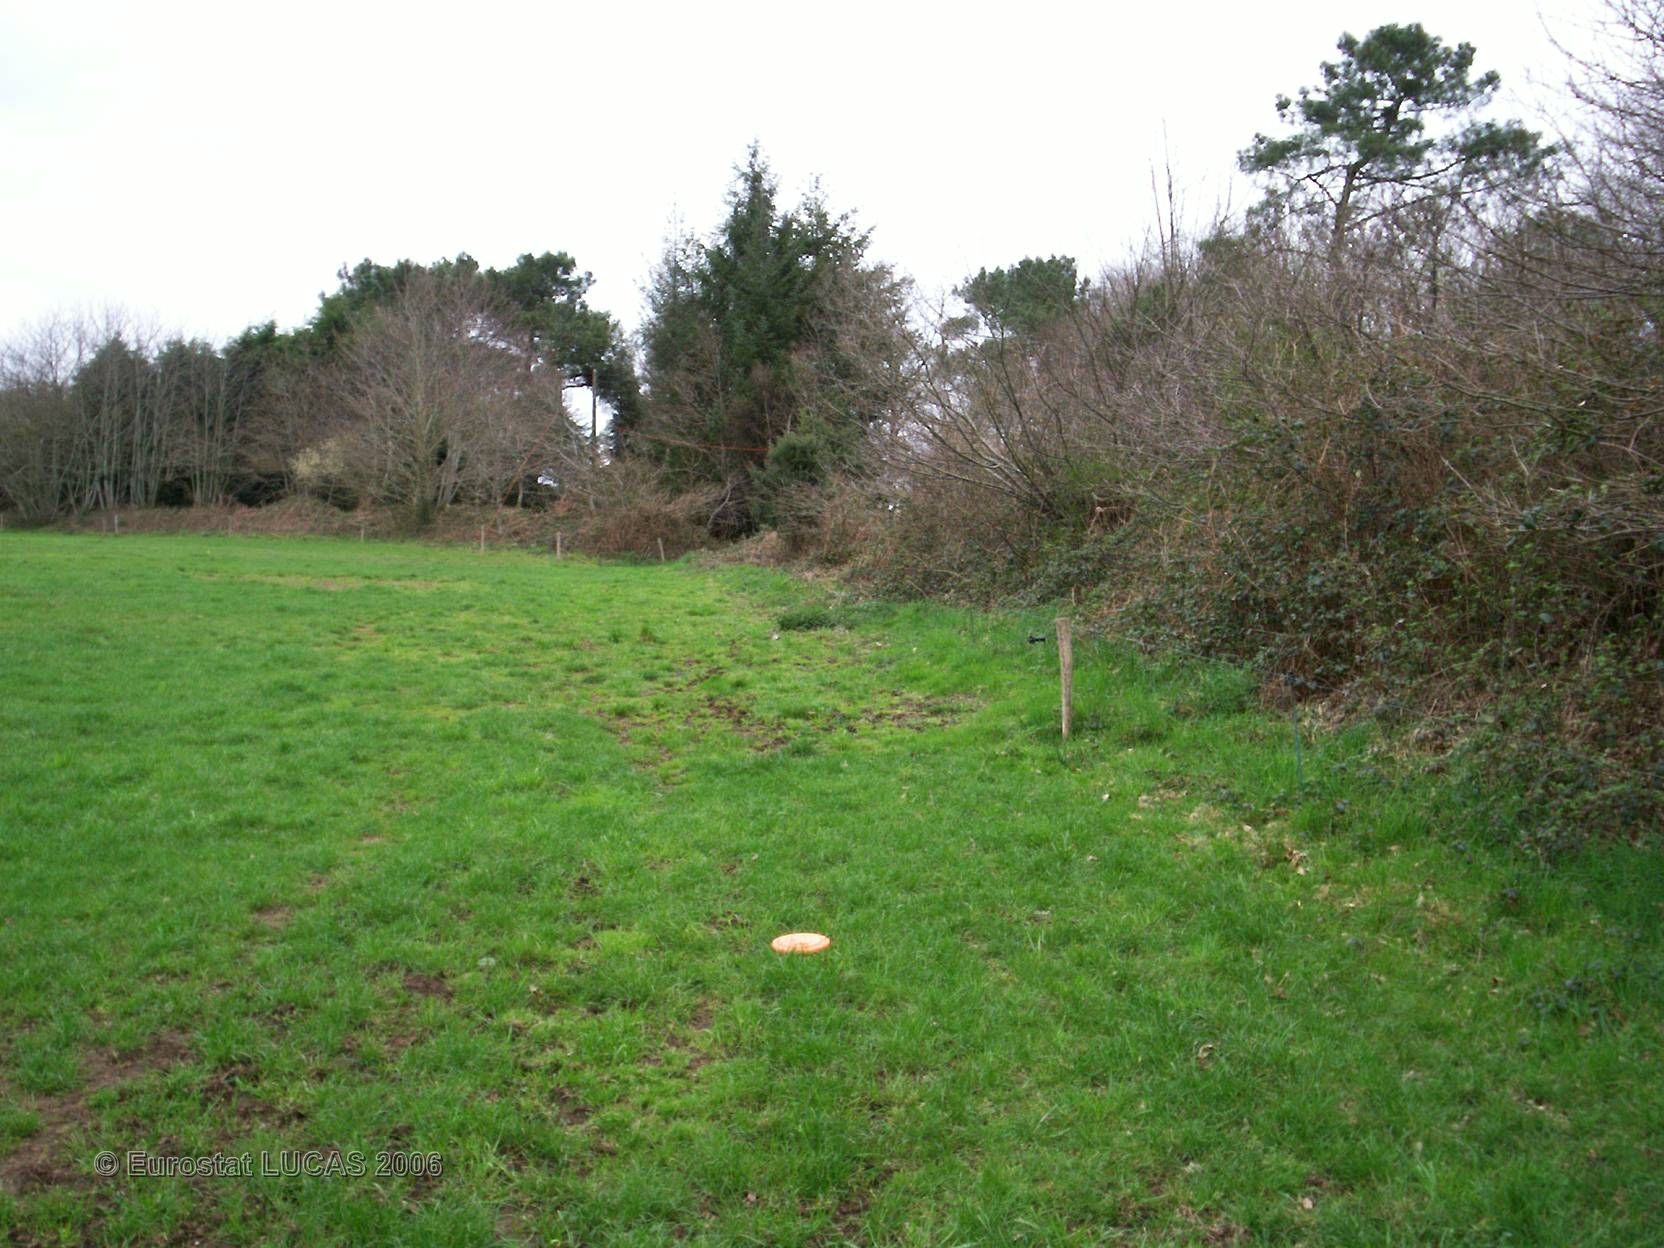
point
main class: Grassland
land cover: Grassland without tree/shrub cover
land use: Agriculture (excluding fallow land and kitchen gardens)
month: April
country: FR
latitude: 47.9530
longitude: -3.5071
